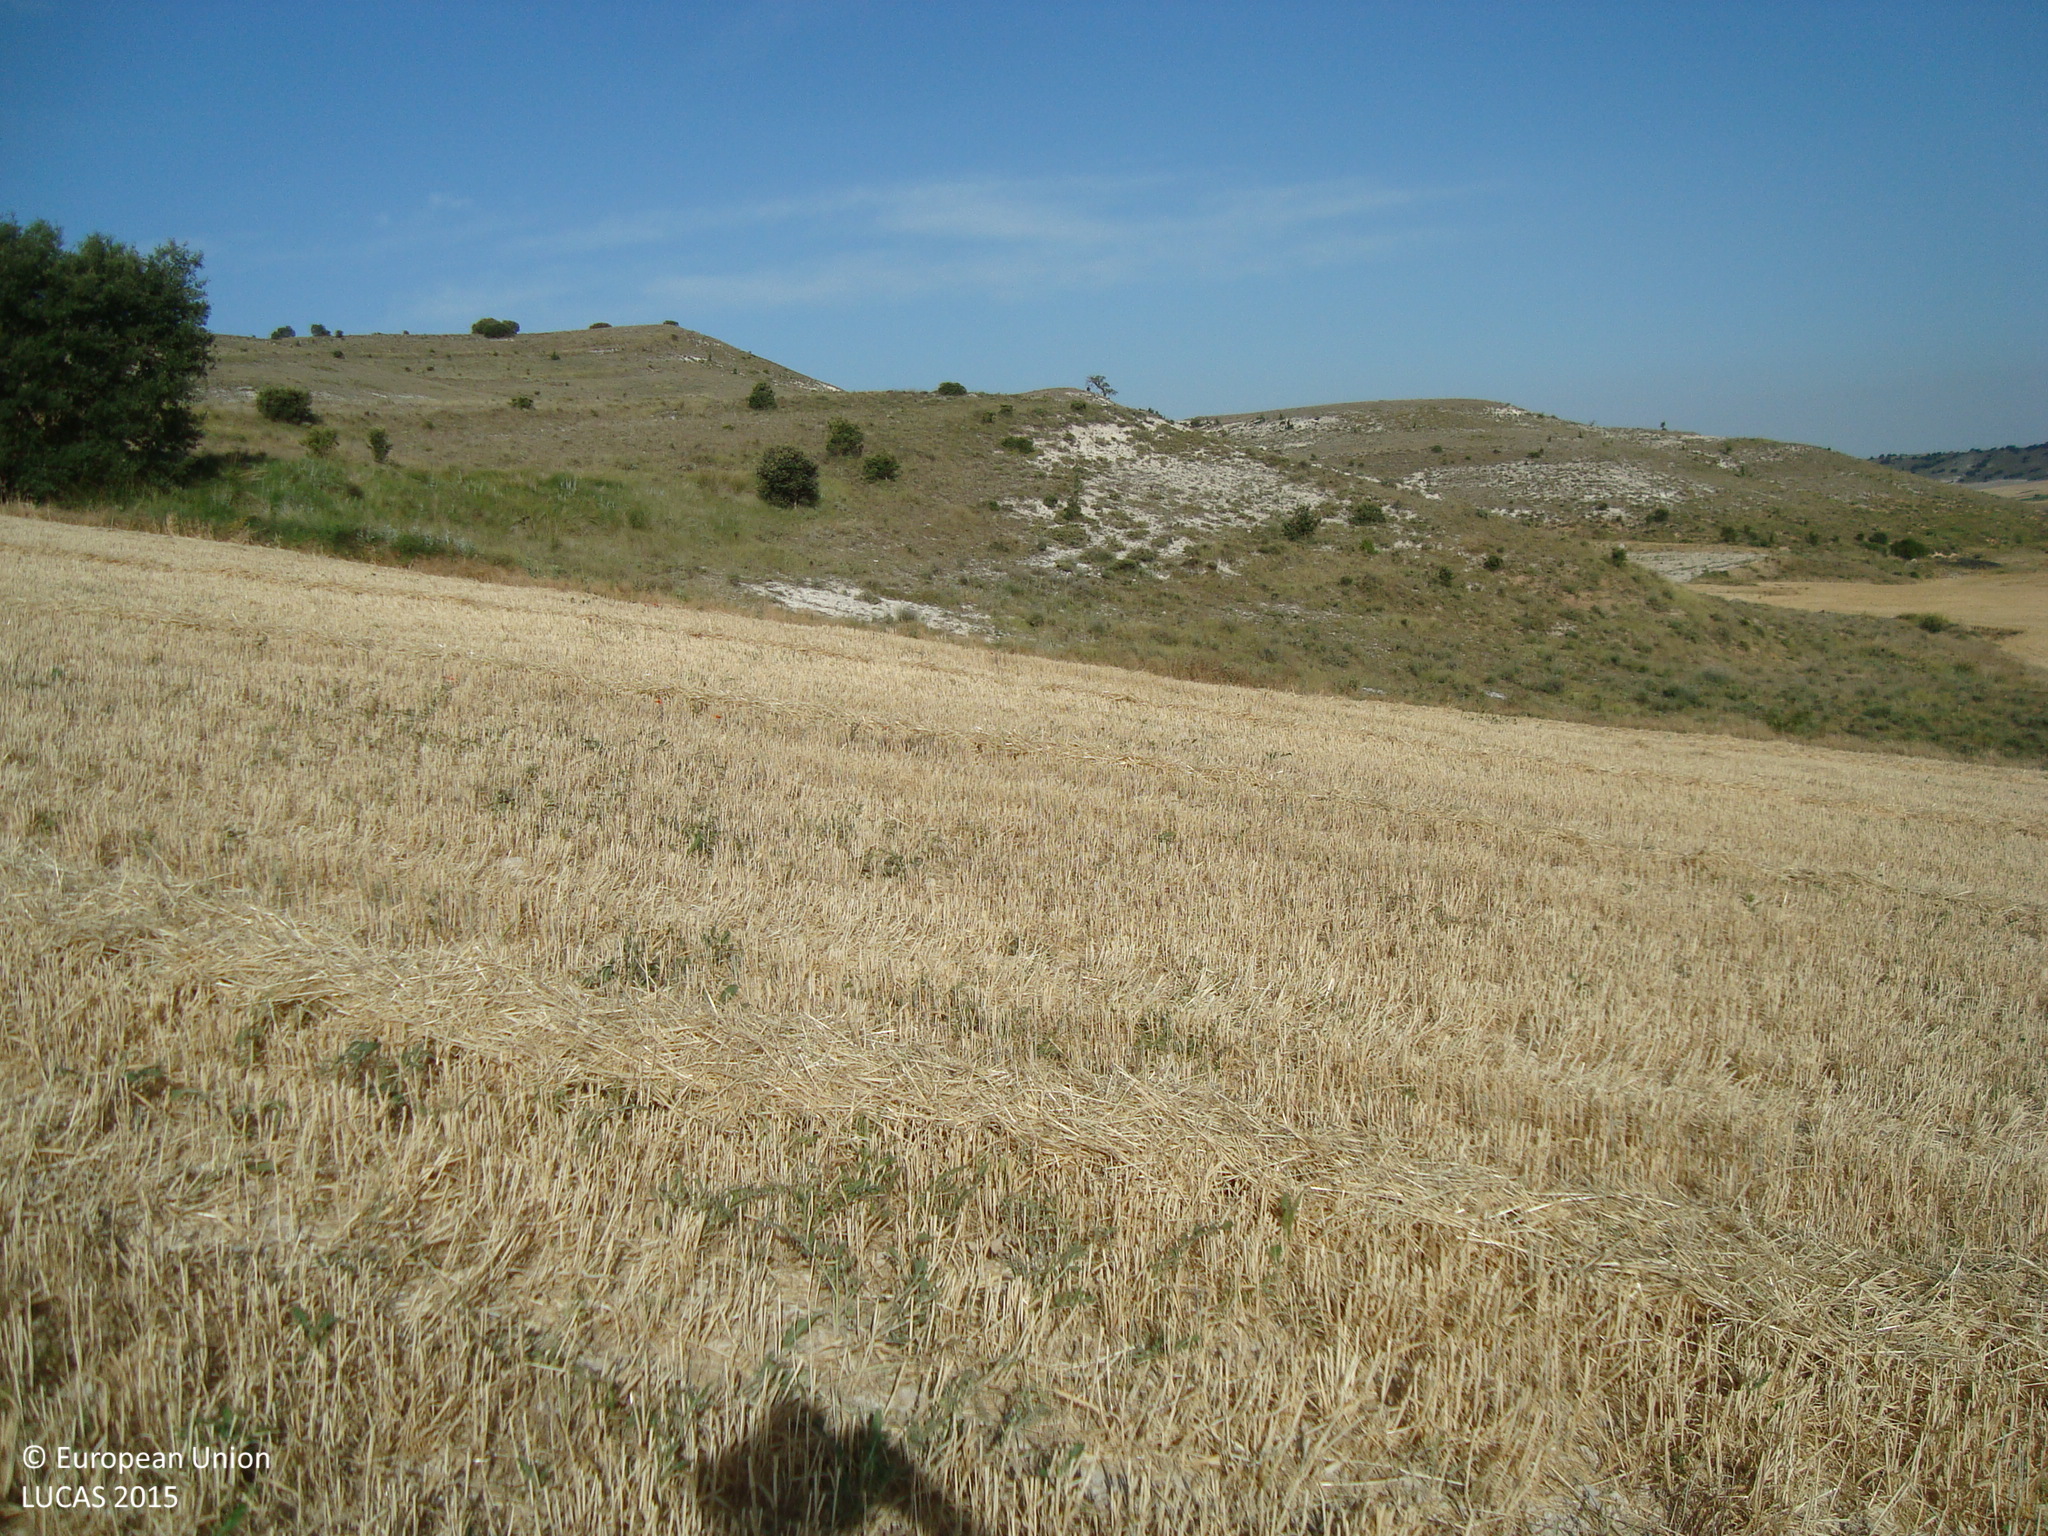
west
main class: Cropland
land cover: Barley
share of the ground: > 75 %
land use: Agriculture (excluding fallow land and kitchen gardens)
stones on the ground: 10 - 25 %
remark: Harvested field
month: July
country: ES
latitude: 41.8648
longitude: -4.2188
